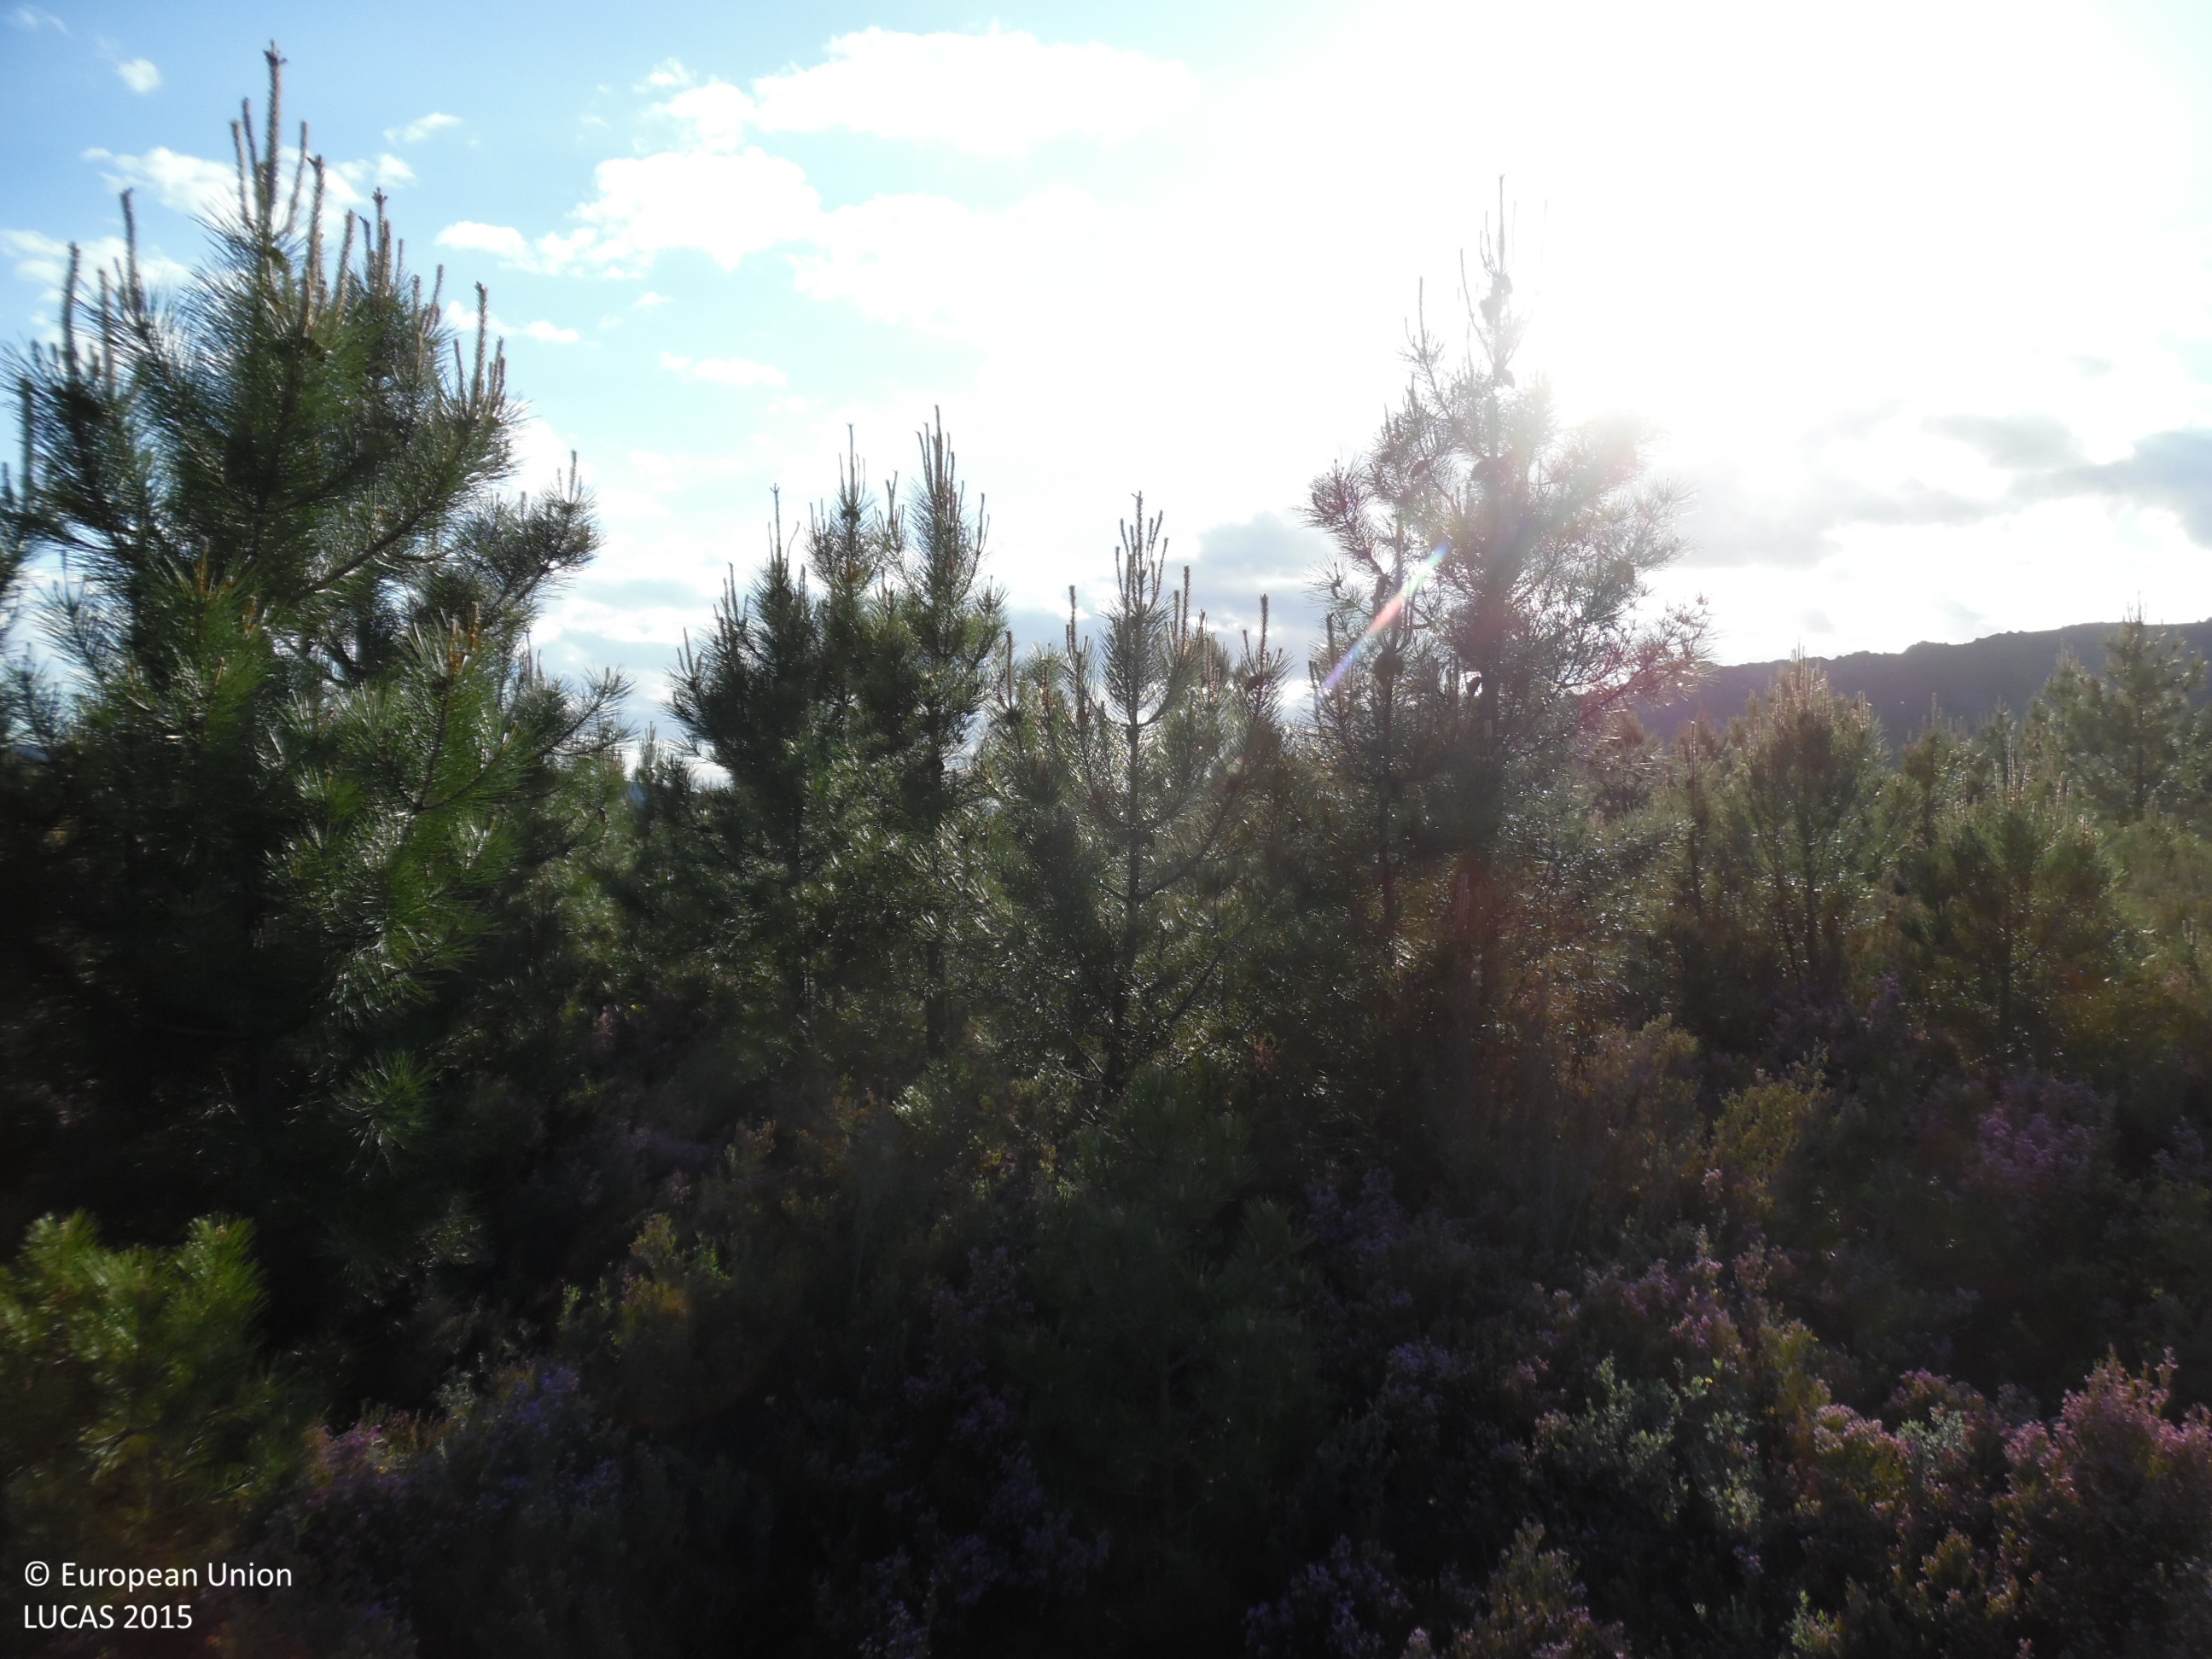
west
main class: Woodland
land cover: Pine dominated coniferous woodland
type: coniferous forest of the mediterranean region
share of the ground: 25 - 50 %
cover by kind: shrubs 55 %, coniferous forest trees 45 %
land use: Forestry
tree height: < 5 m
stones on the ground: 10 - 25 %
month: May
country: ES
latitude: 42.1918
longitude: -6.2731
